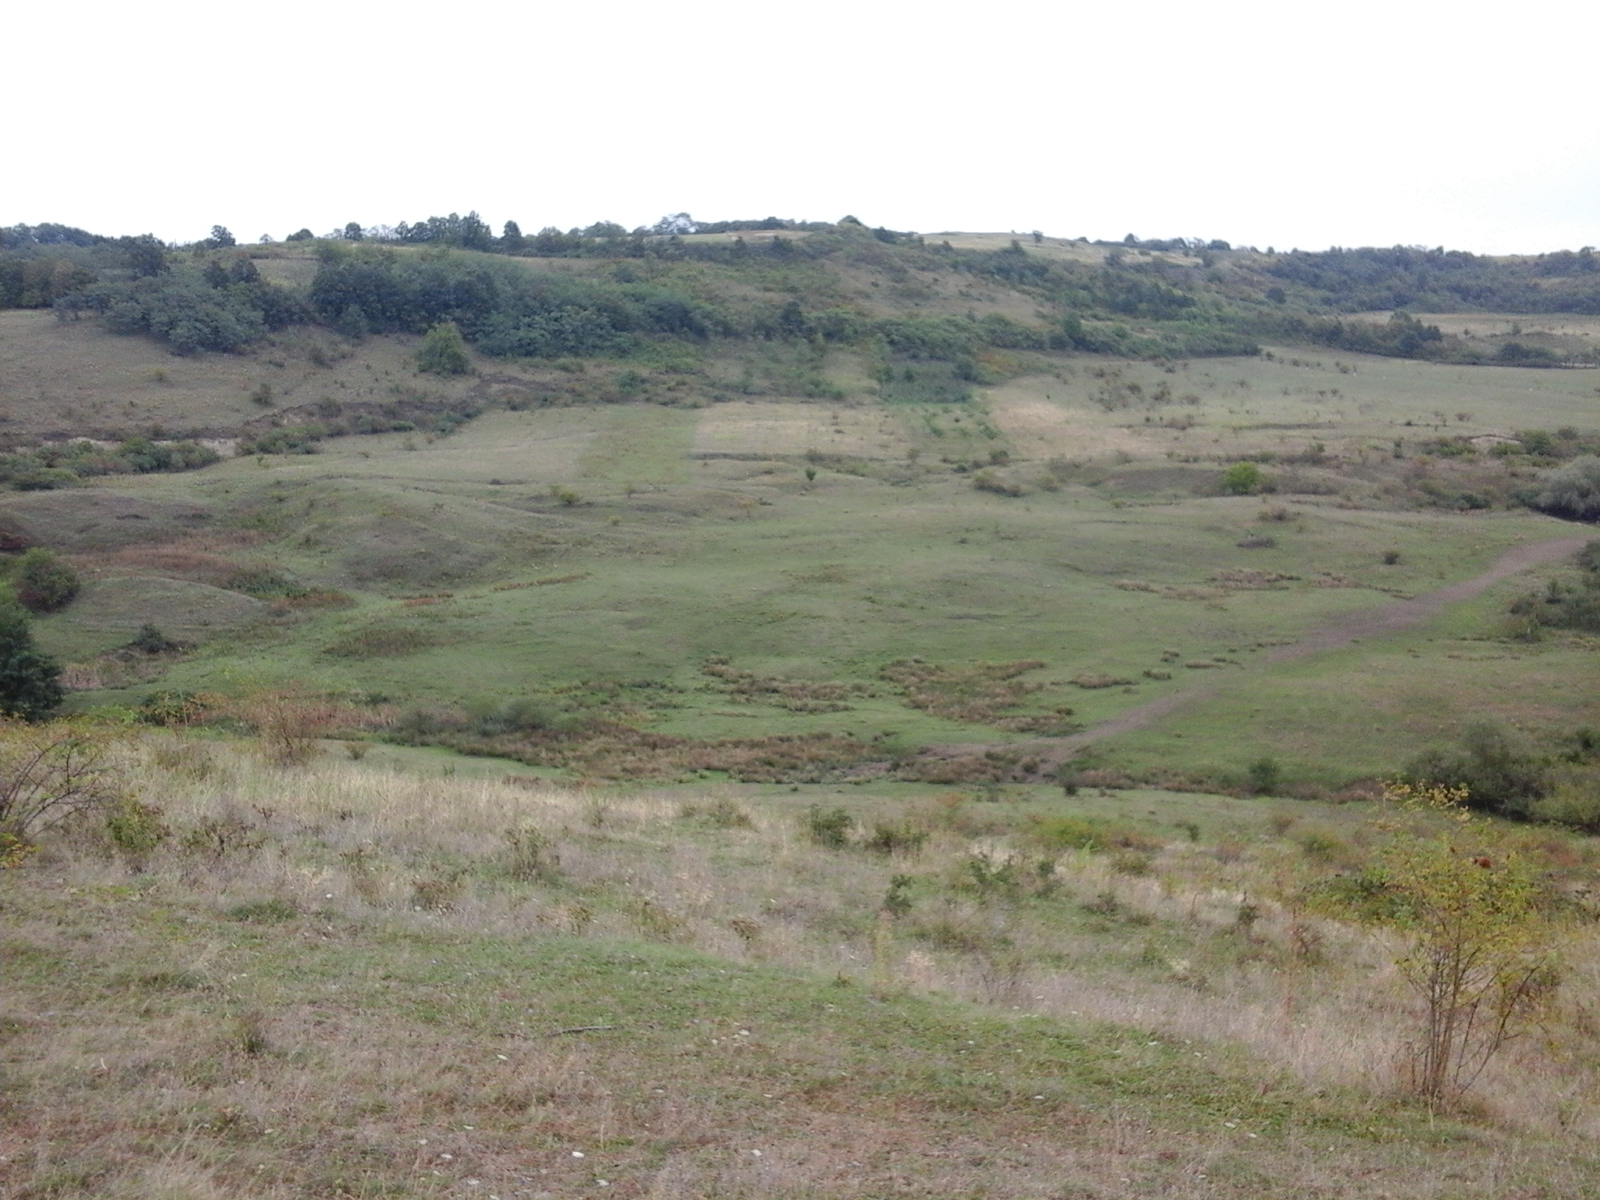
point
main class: Grassland
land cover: Grassland with sparse tree/shrub cover
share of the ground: > 75 %
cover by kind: herbaceous plants 85 %, shrubs 10 %, broadleaved forest trees 5 %
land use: Agriculture (excluding fallow land and kitchen gardens)
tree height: < 5 m
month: September
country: RO
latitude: 47.3259
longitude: 22.5071
